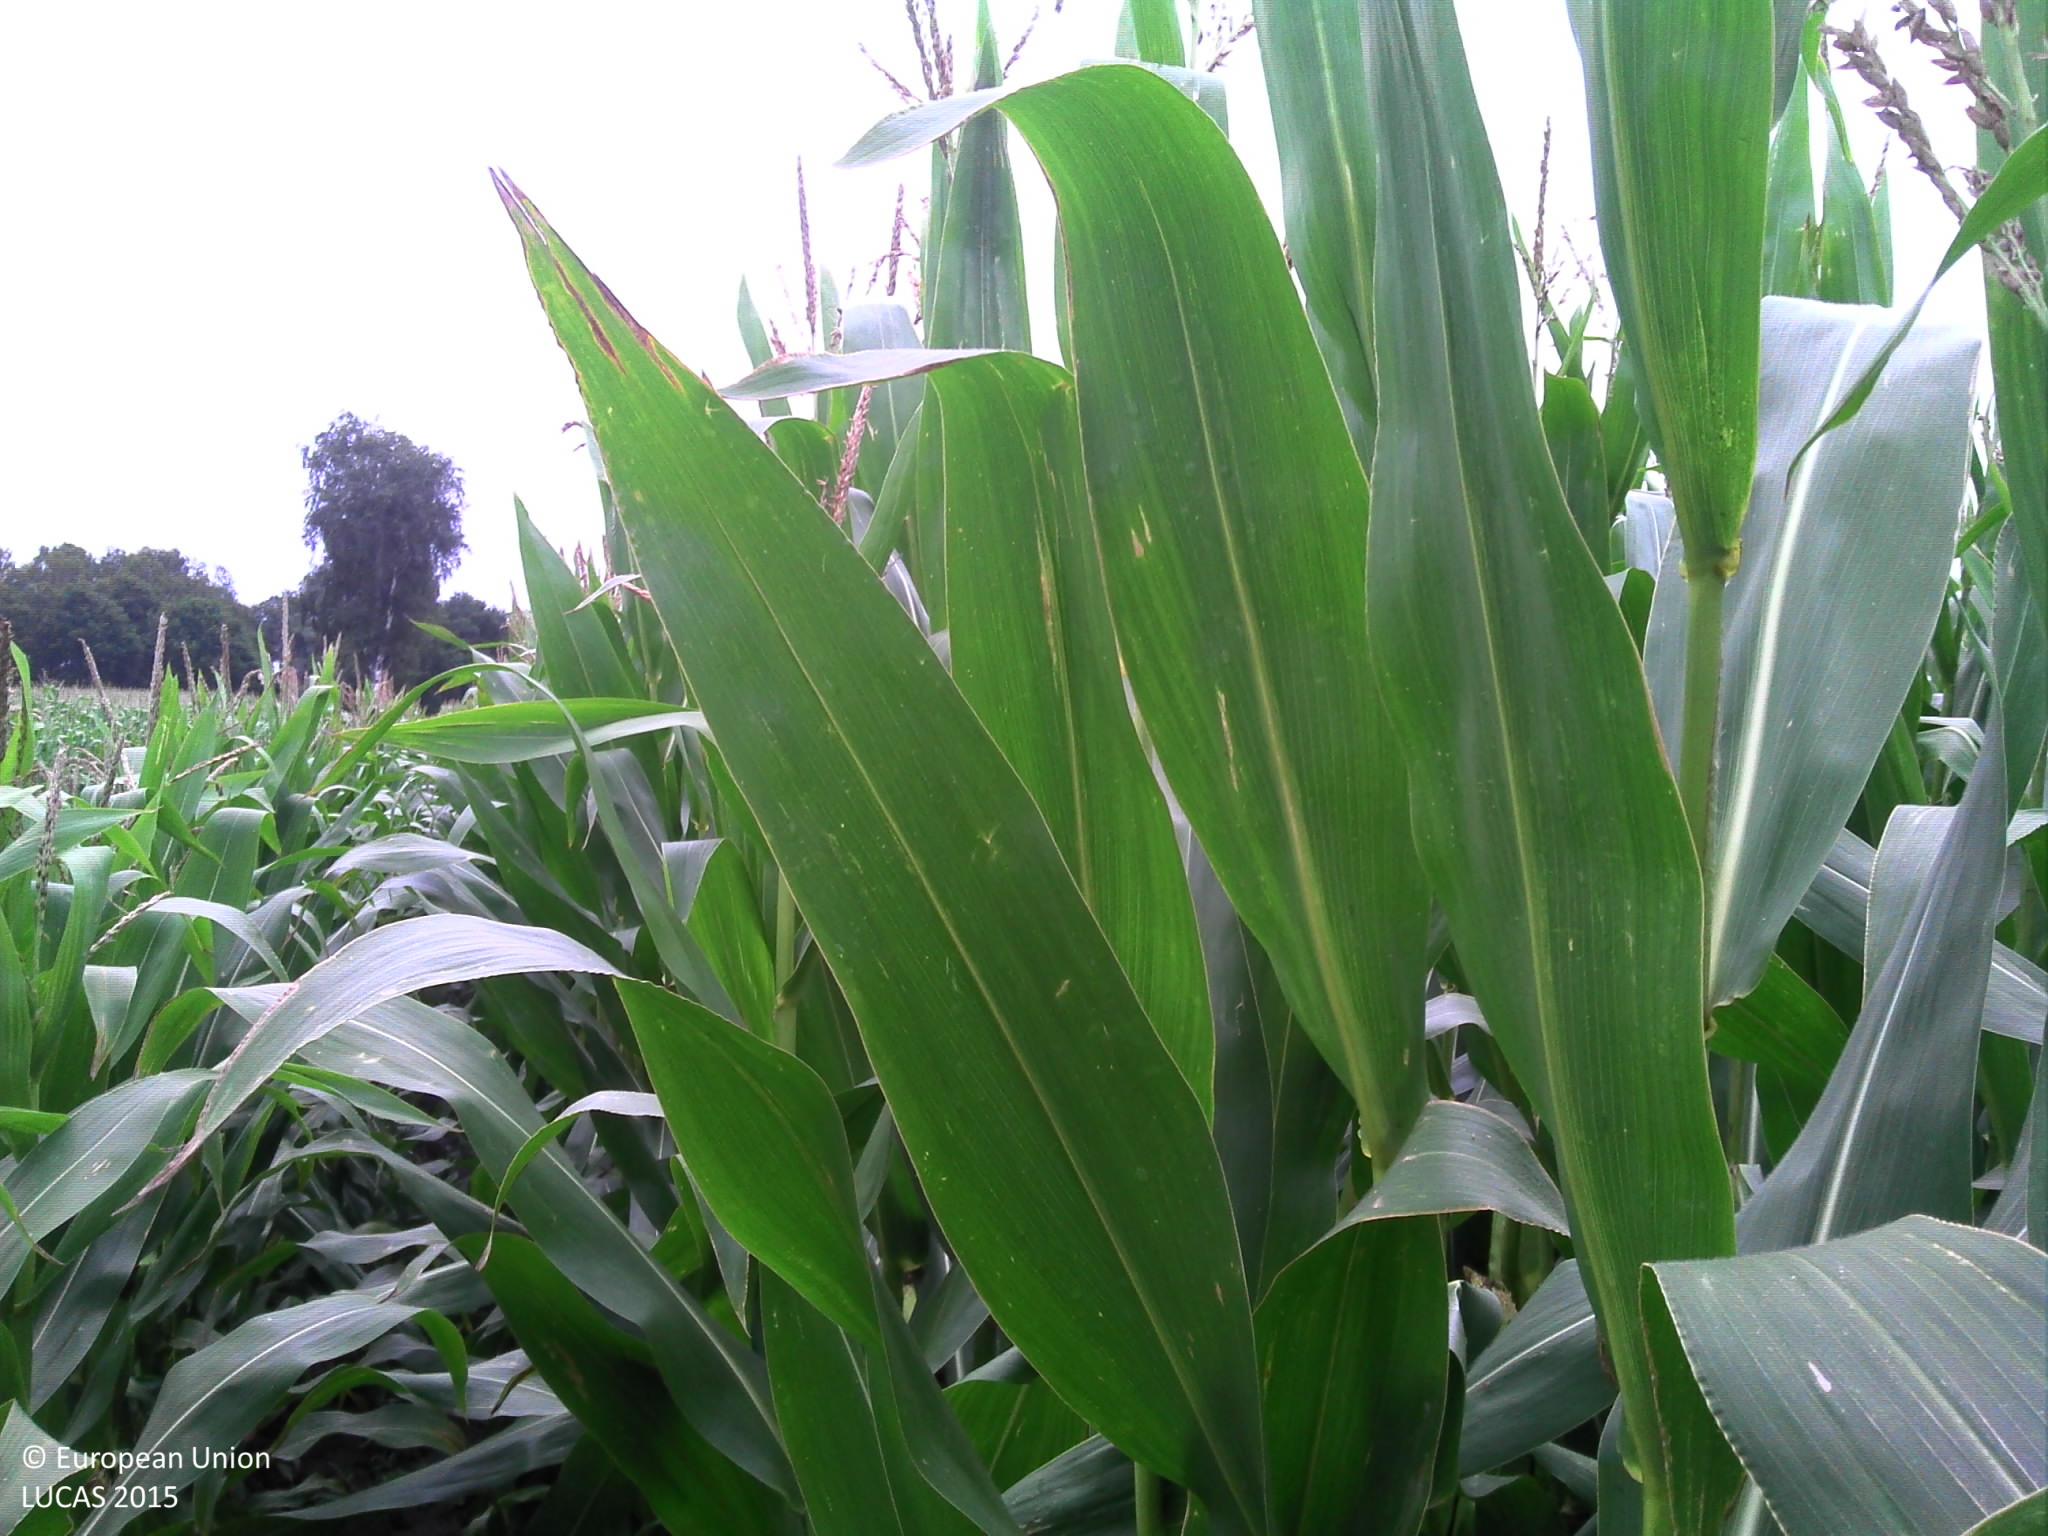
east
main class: Cropland
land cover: Maize
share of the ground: > 75 %
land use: Agriculture (excluding fallow land and kitchen gardens)
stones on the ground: < 10 %
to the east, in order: Maize; Grass margins; Tracks; Grass margins; Broadleaved woodland
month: August
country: BE
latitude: 51.3065
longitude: 5.1633
